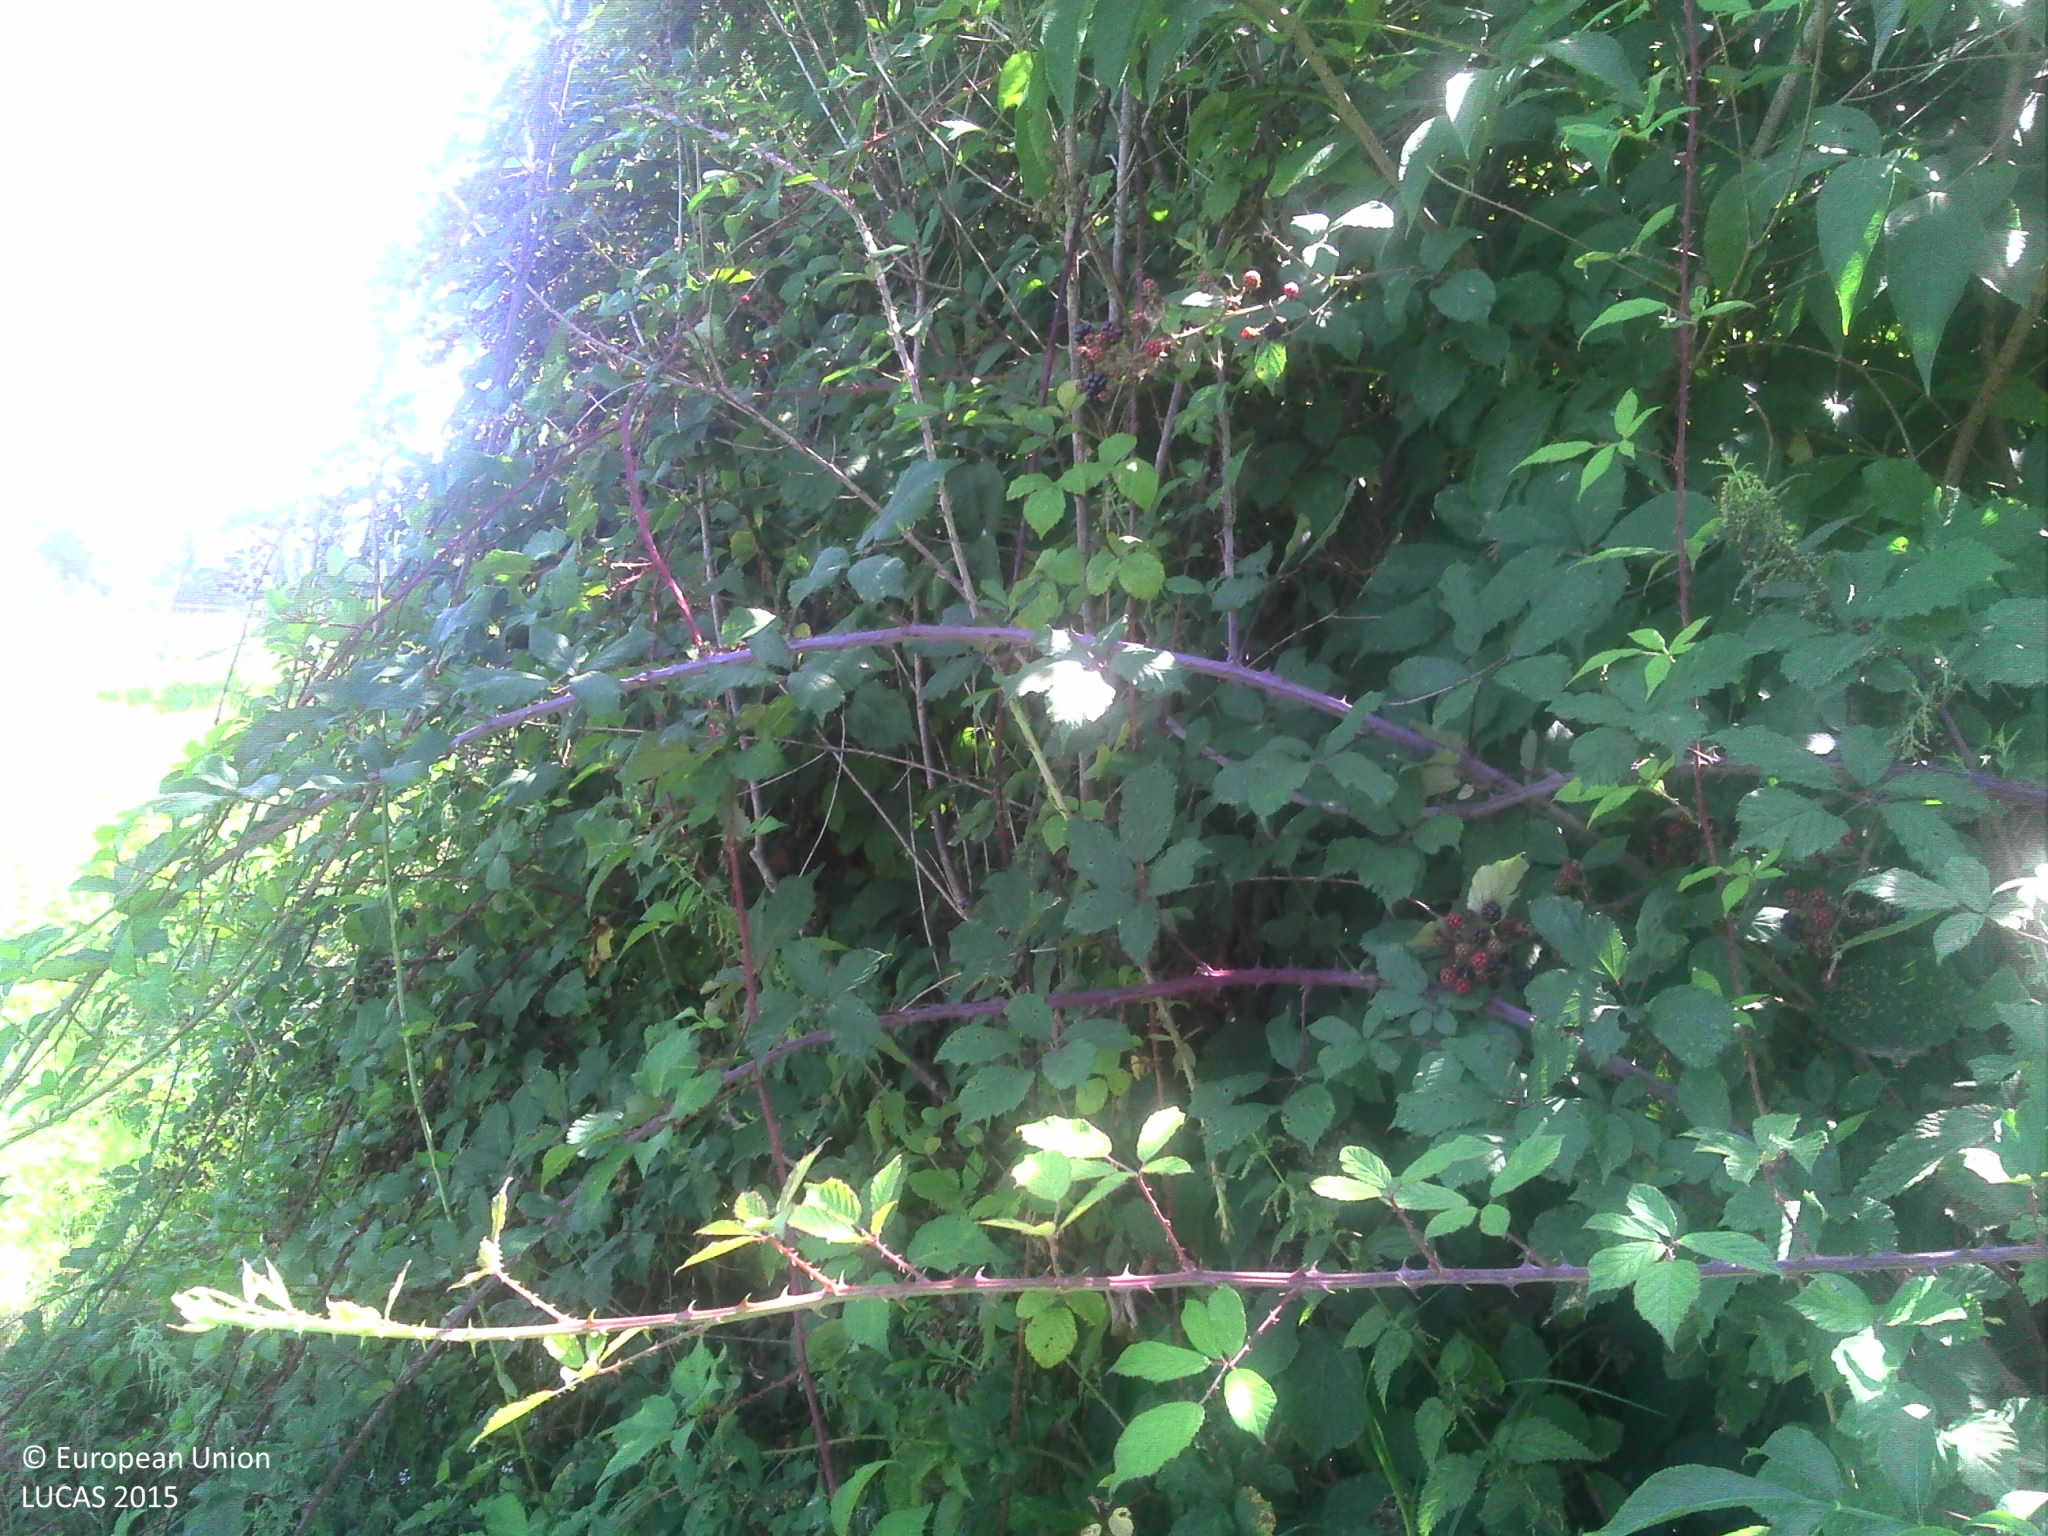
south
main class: Grassland
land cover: Grassland without tree/shrub cover
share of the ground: > 75 %
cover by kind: herbaceous plants 95 %, shrubs 5 %
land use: Agriculture (excluding fallow land and kitchen gardens)
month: August
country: FR
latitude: 45.2810
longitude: 1.4145
